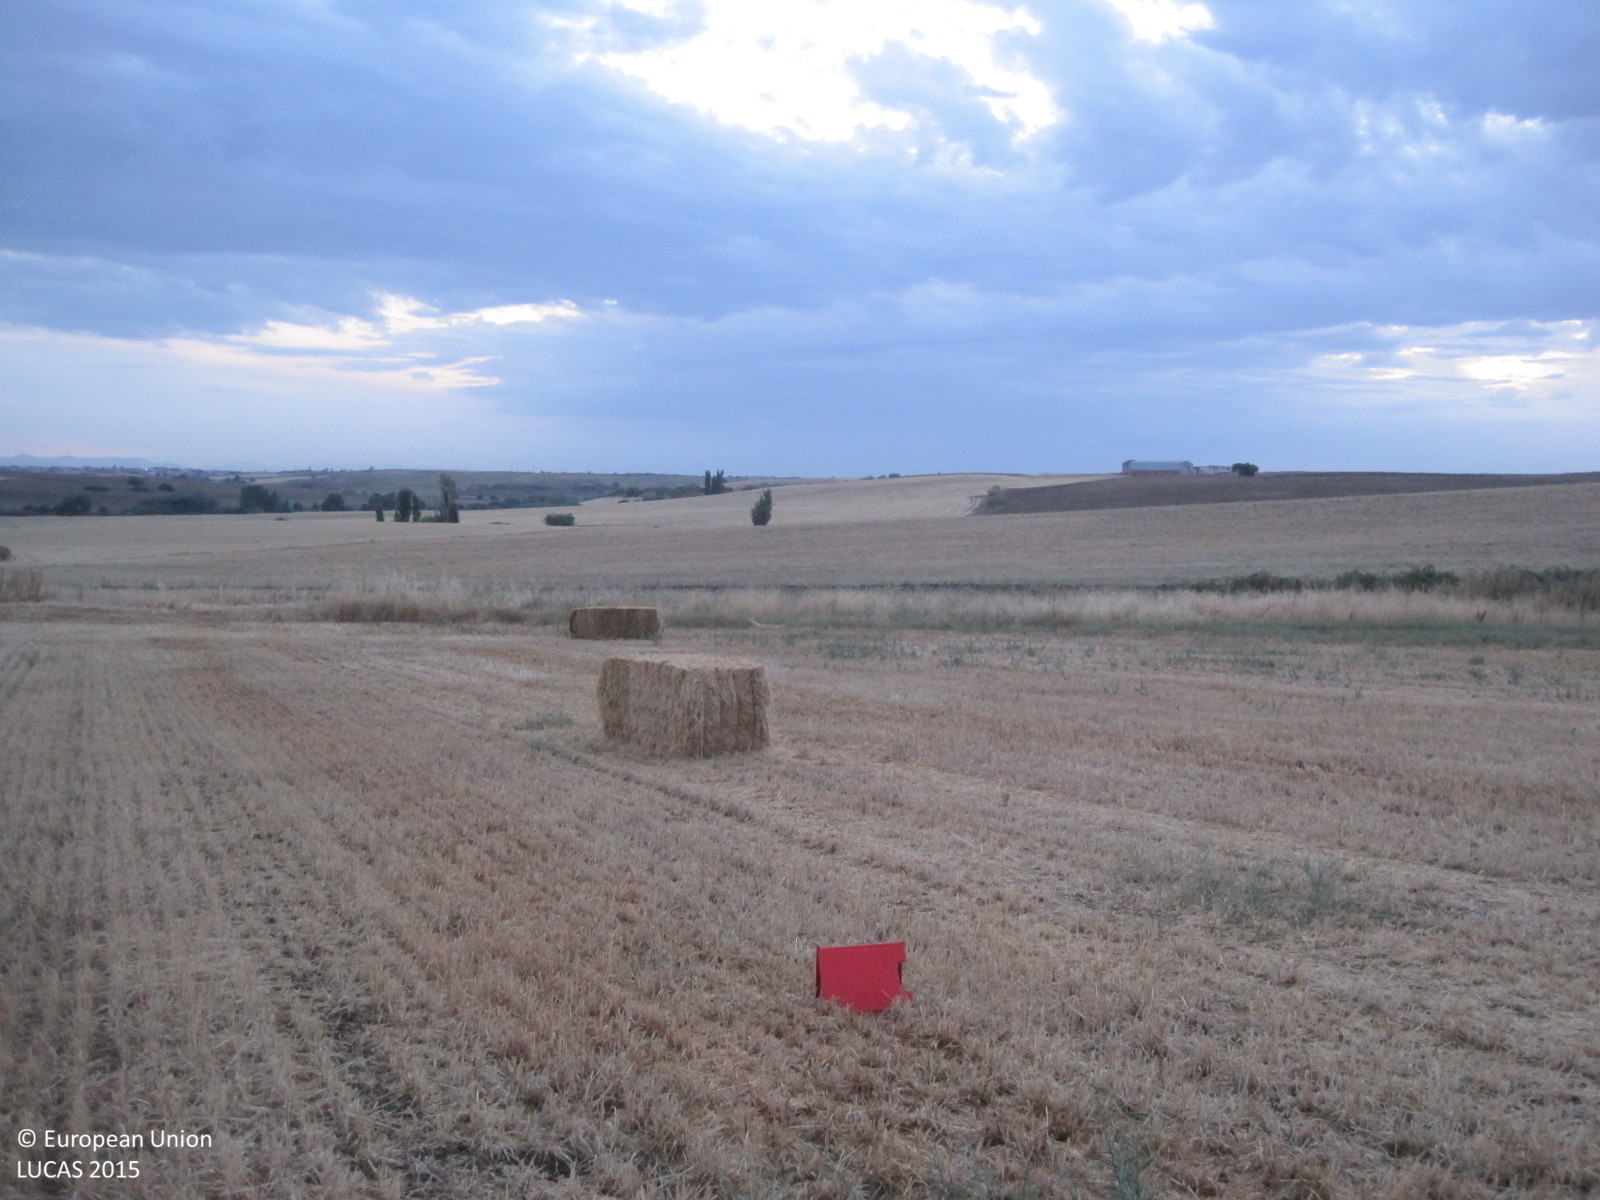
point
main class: Cropland
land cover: Oats
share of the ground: < 10 %
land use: Agriculture (excluding fallow land and kitchen gardens)
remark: Harvested field
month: July
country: ES
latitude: 40.0707
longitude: -4.3349
